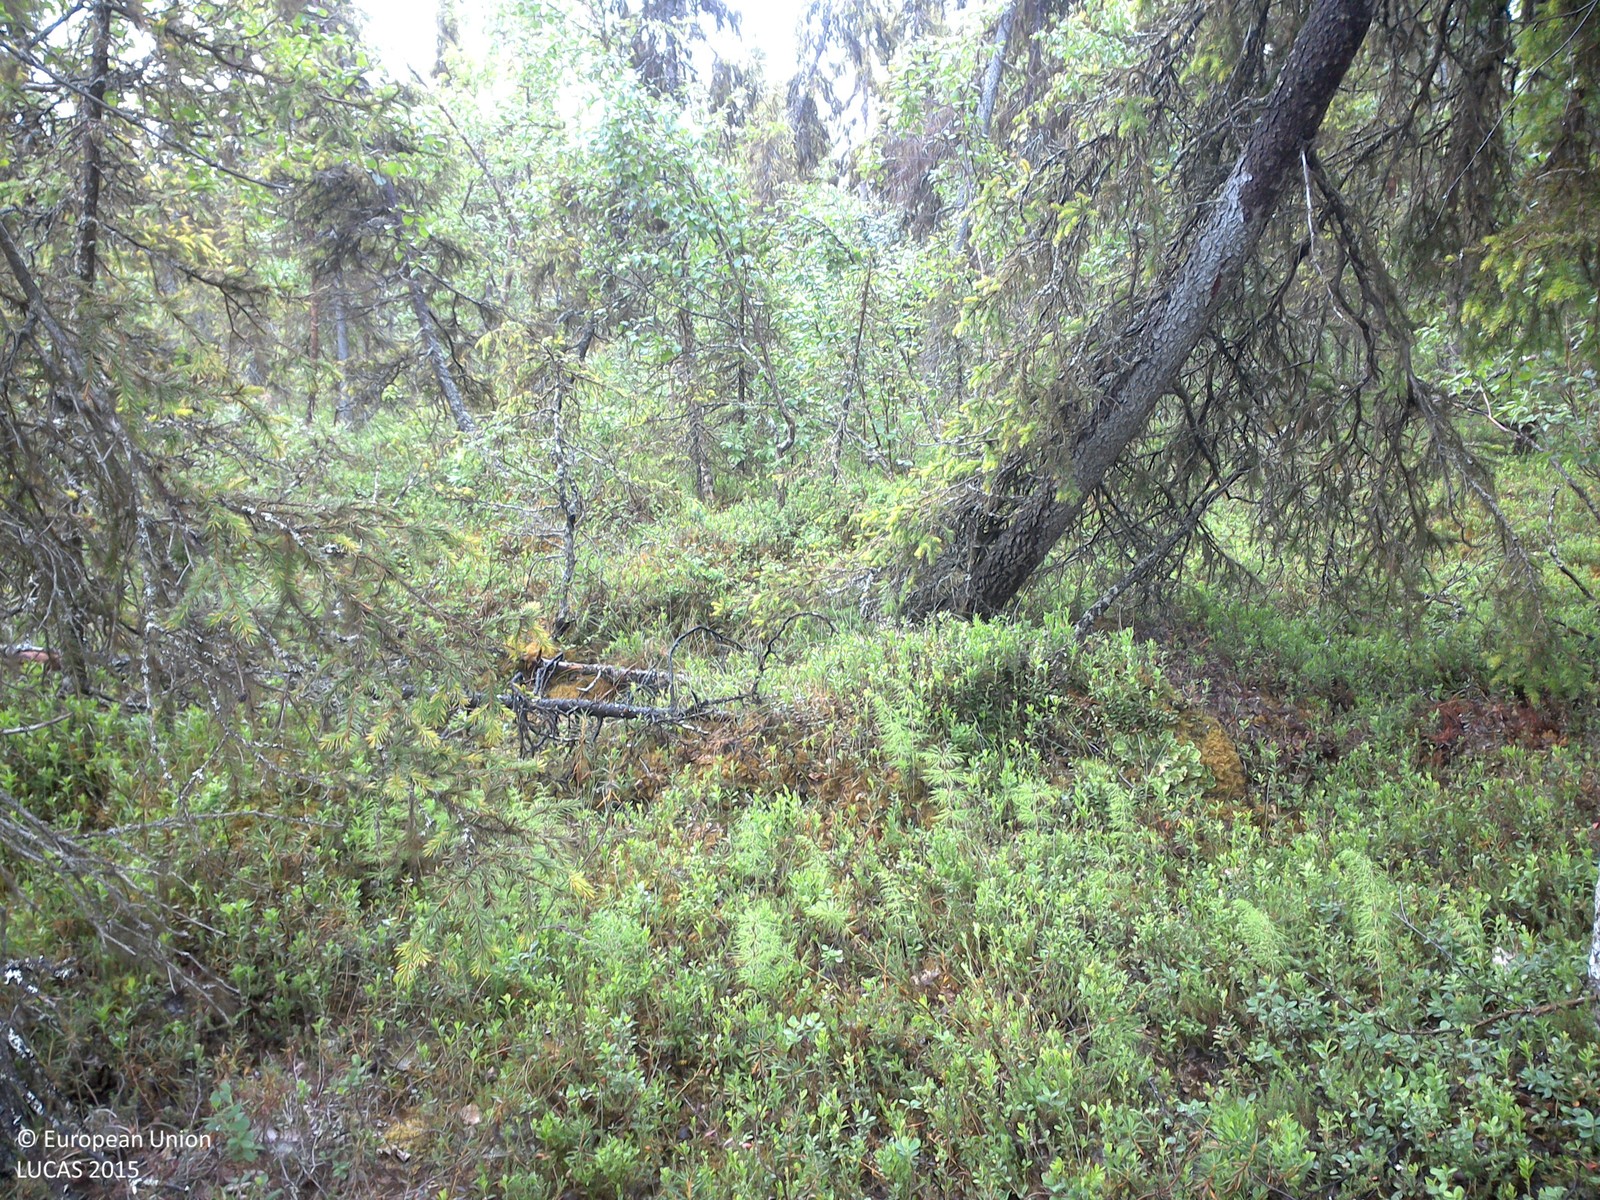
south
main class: Woodland
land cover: Spruce dominated mixed woodland
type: boreal forest
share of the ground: 25 - 50 %
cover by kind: shrubs 55 %, coniferous forest trees 25 %, broadleaved forest trees 15 %, lichens and mosses 5 %
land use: Forestry
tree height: > 5 m
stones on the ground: < 10 %
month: July
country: SE
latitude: 67.8173
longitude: 23.4683
